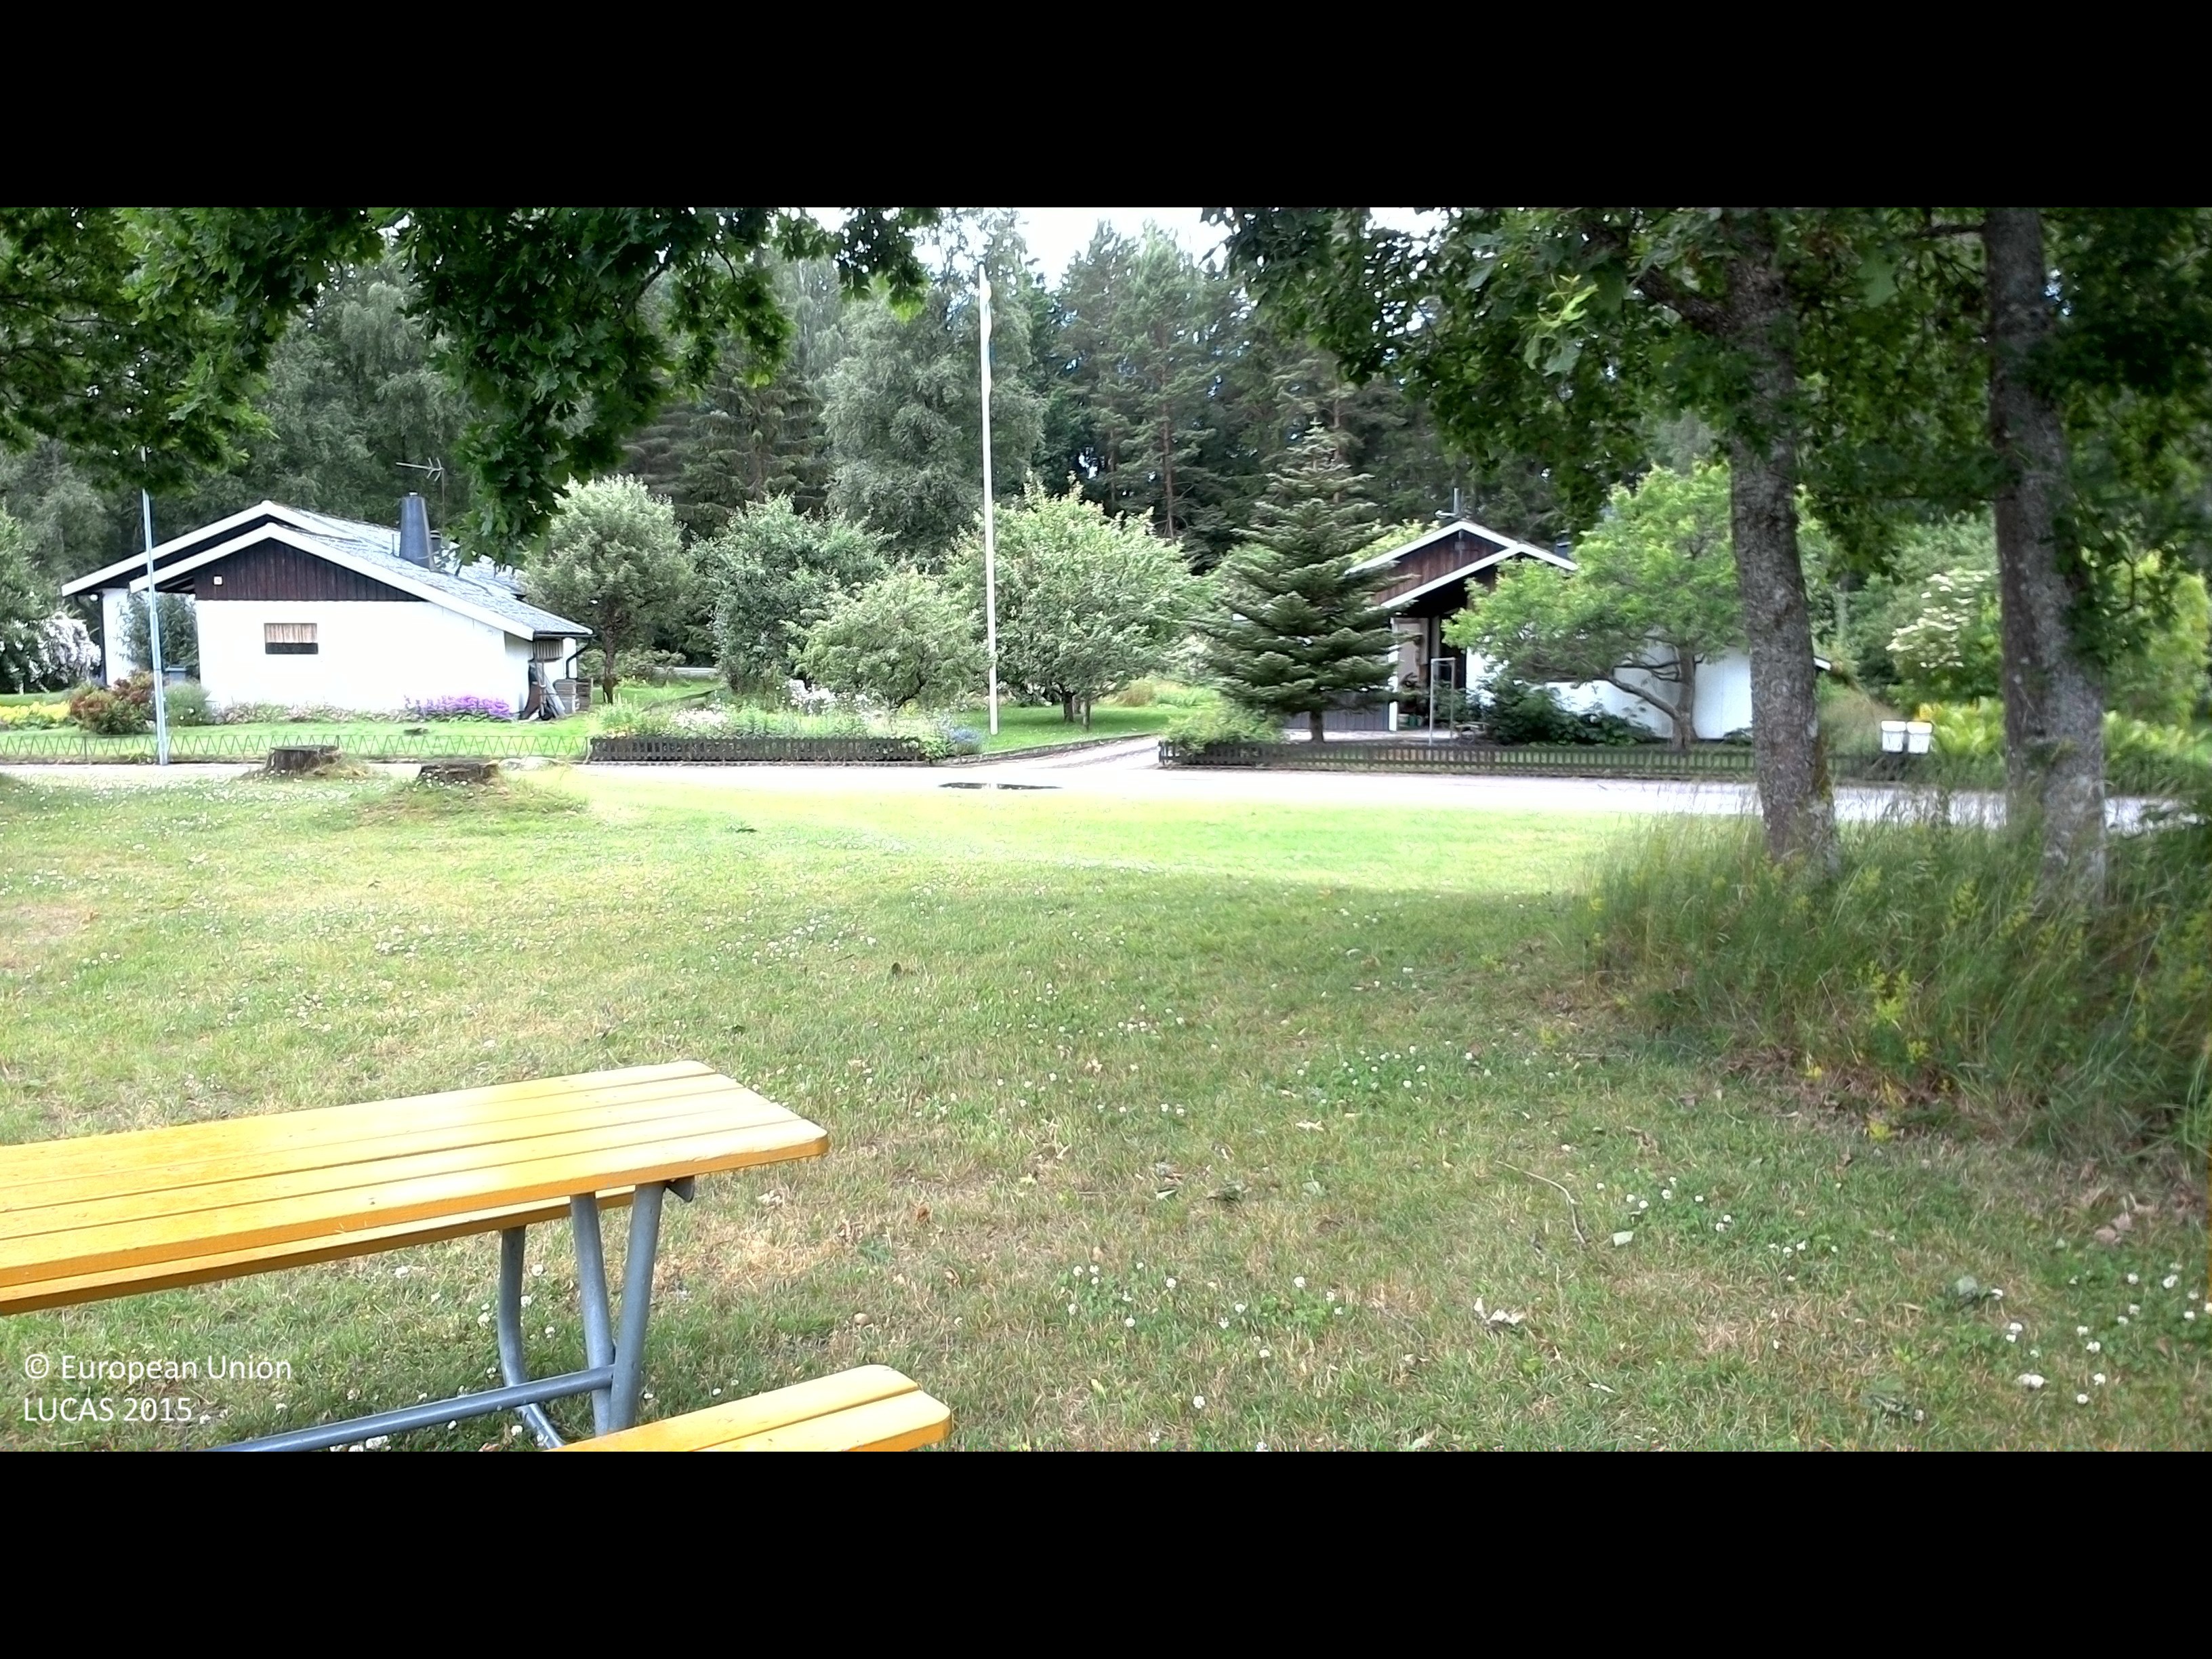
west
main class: Grassland
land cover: Grassland without tree/shrub cover
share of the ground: > 75 %
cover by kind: herbaceous plants 100 %
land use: Amenities, museums, leisure
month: July
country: SE
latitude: 56.4624
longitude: 14.6880
